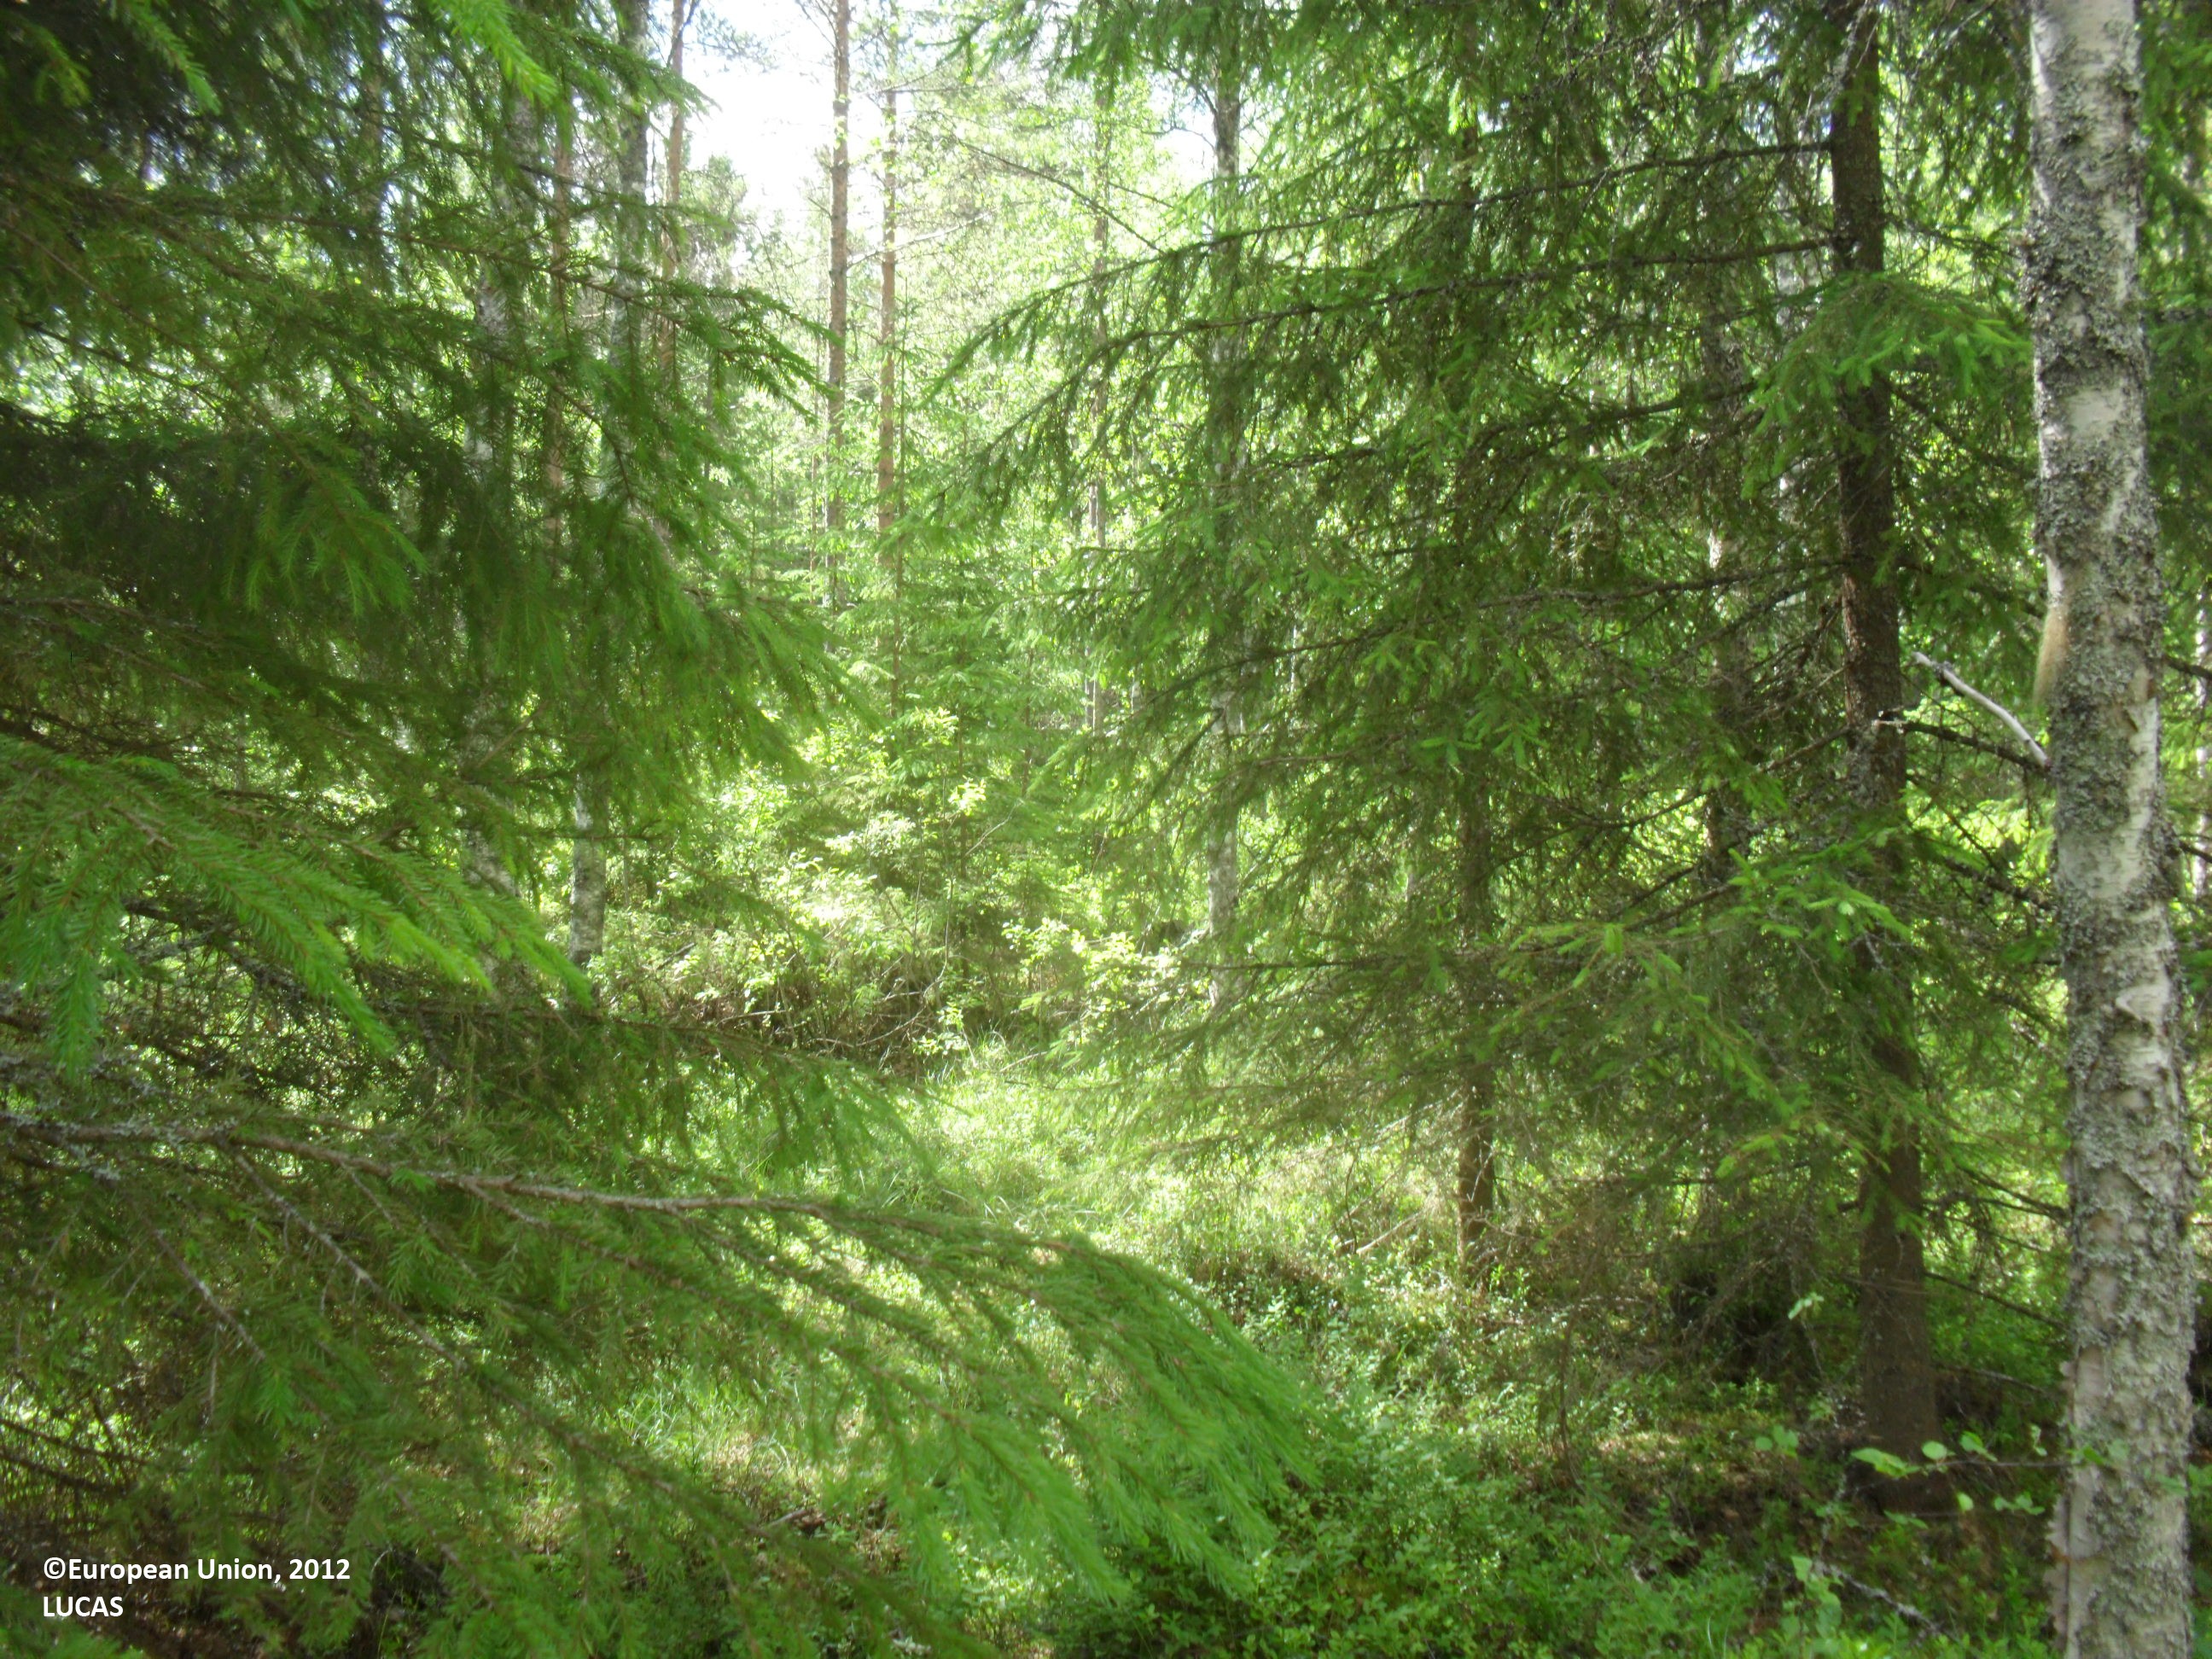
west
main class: Woodland
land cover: Other mixed woodland
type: boreal forest
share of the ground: 50 - 75 %
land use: Forestry
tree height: > 5 m
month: July
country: FI
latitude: 62.9412
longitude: 24.2477
